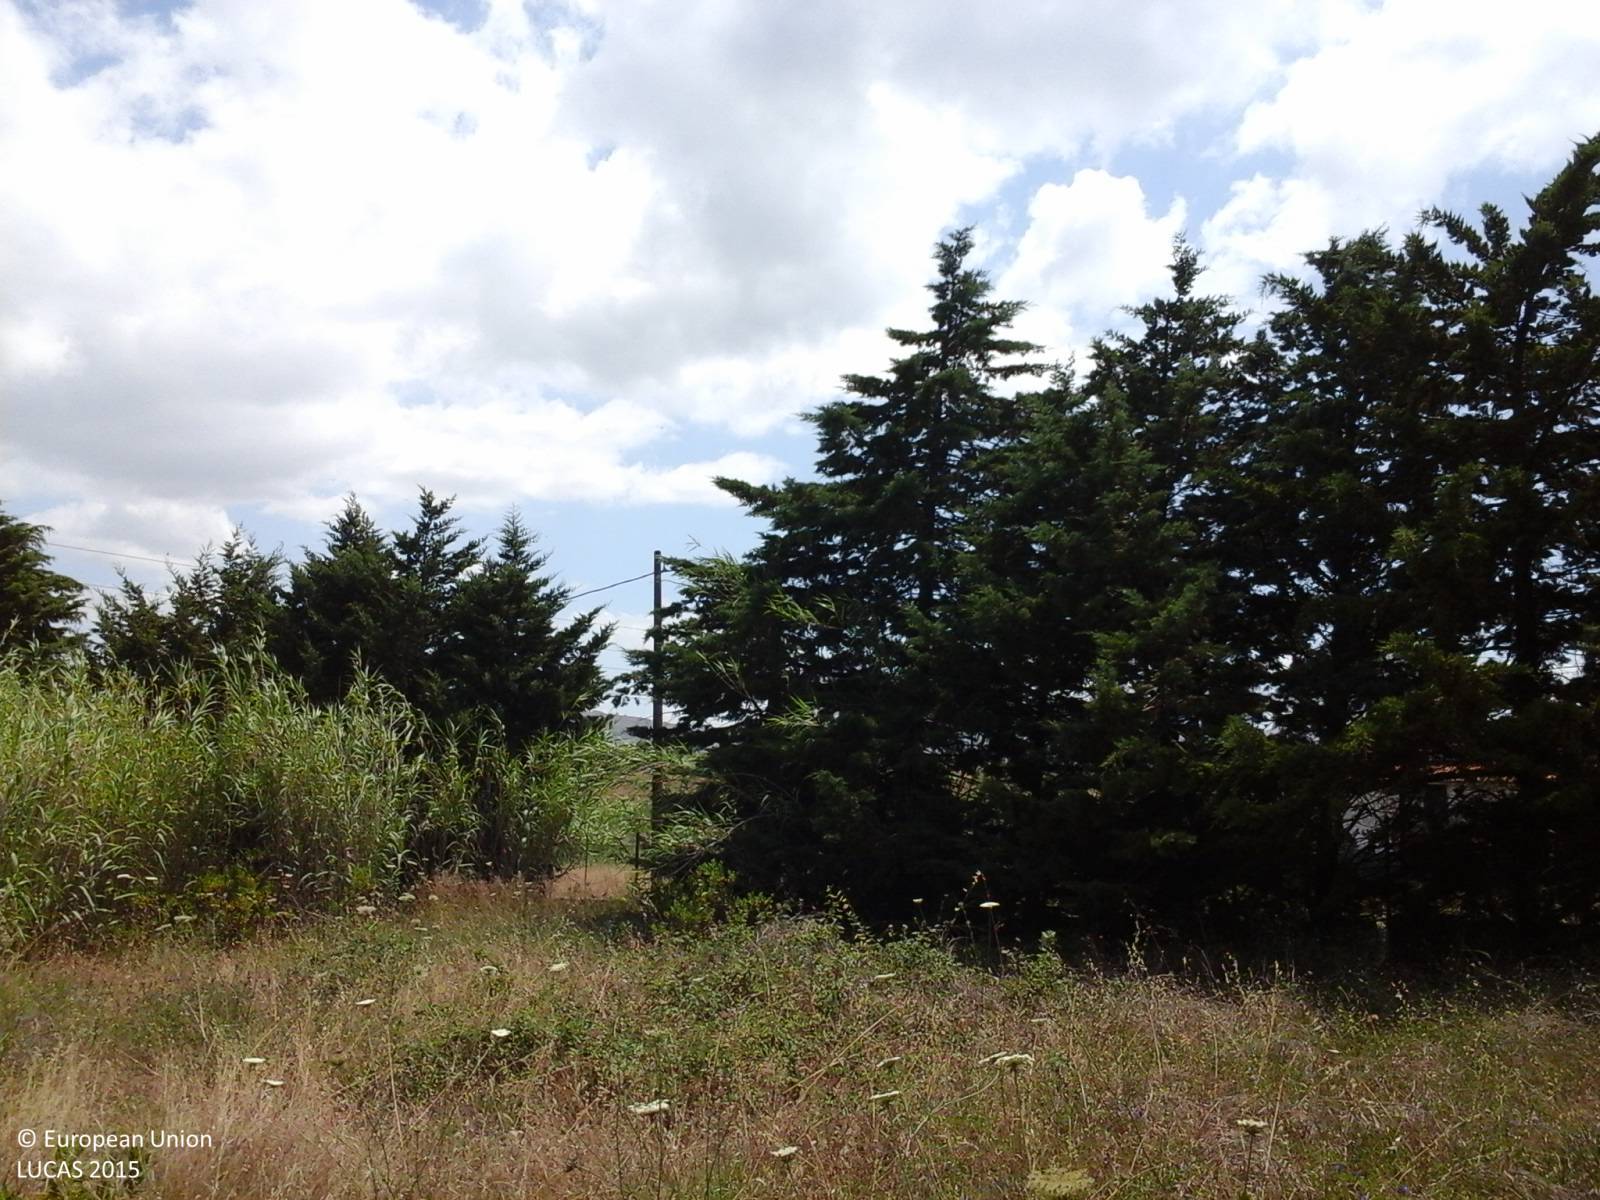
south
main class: Grassland
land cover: Grassland without tree/shrub cover
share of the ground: > 75 %
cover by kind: herbaceous plants 100 %
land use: Abandoned areas
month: June
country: IT
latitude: 38.0243
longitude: 13.0879
